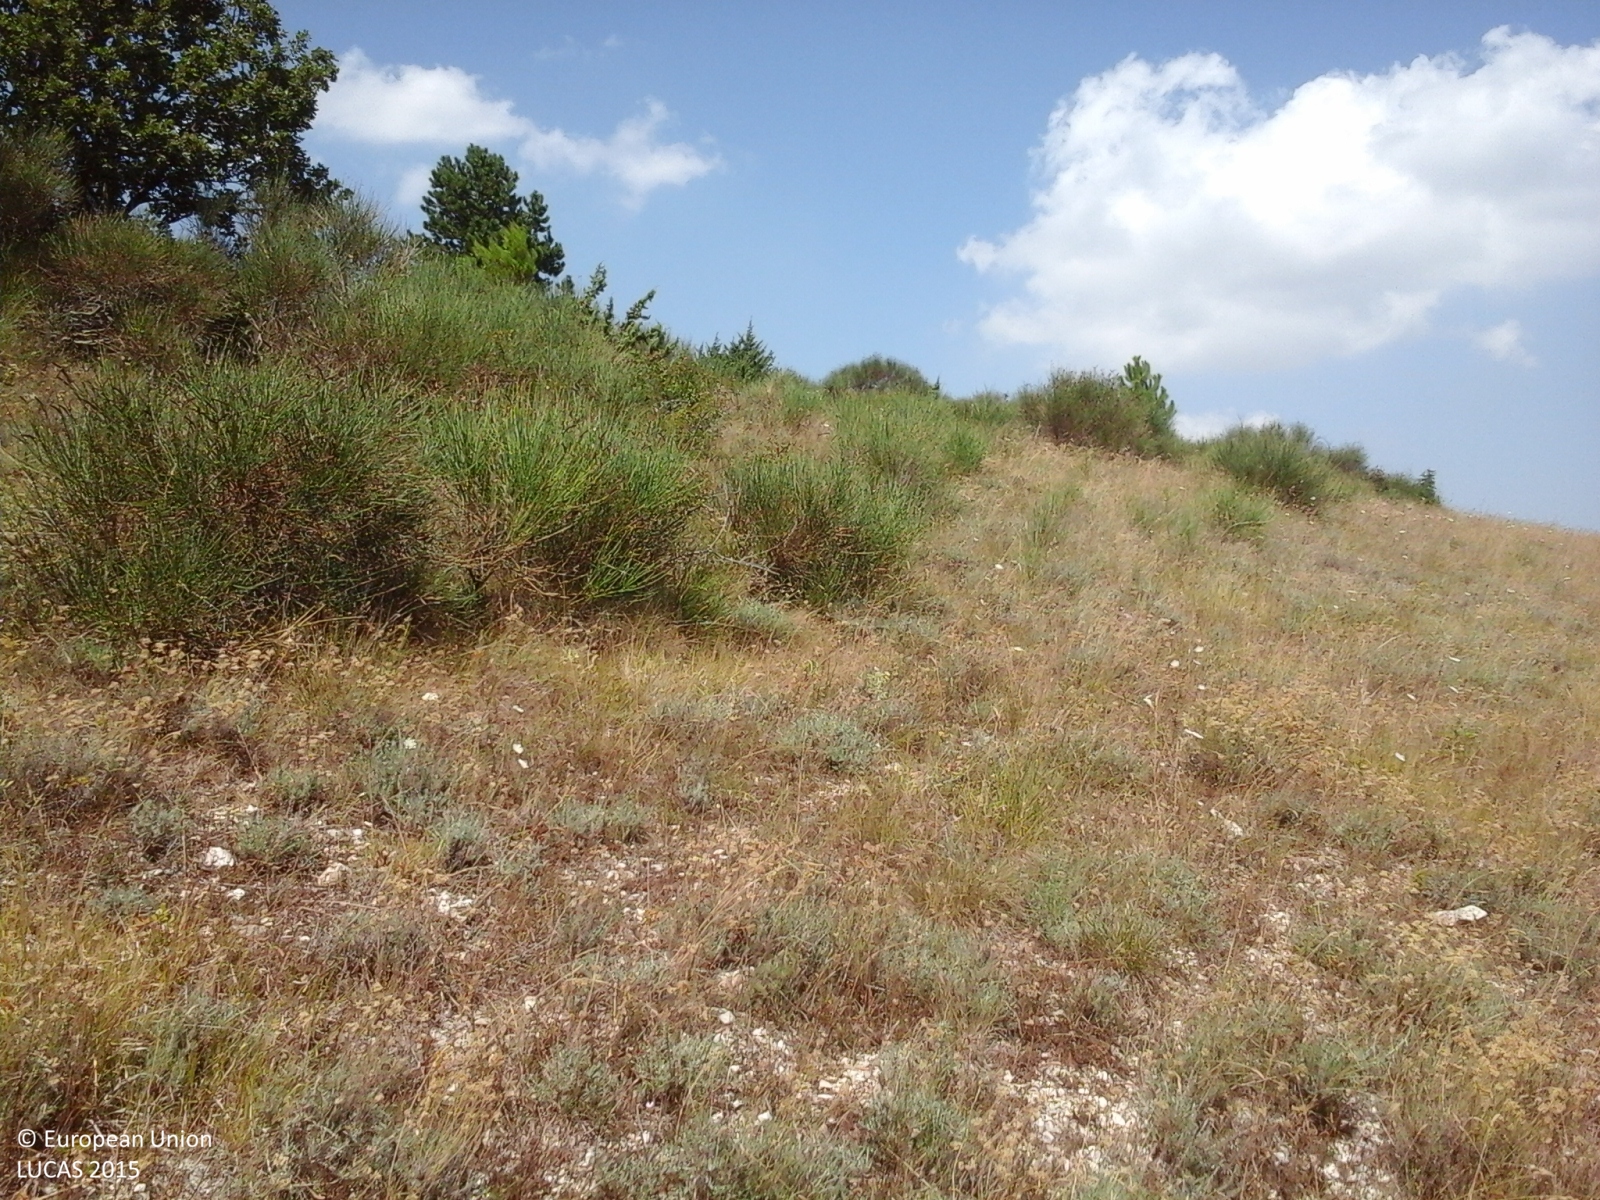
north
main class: Grassland
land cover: Grassland without tree/shrub cover
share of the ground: > 75 %
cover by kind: herbaceous plants 95 %, shrubs 5 %
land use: Agriculture (excluding fallow land and kitchen gardens)
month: August
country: IT
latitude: 43.3432
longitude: 13.2359
